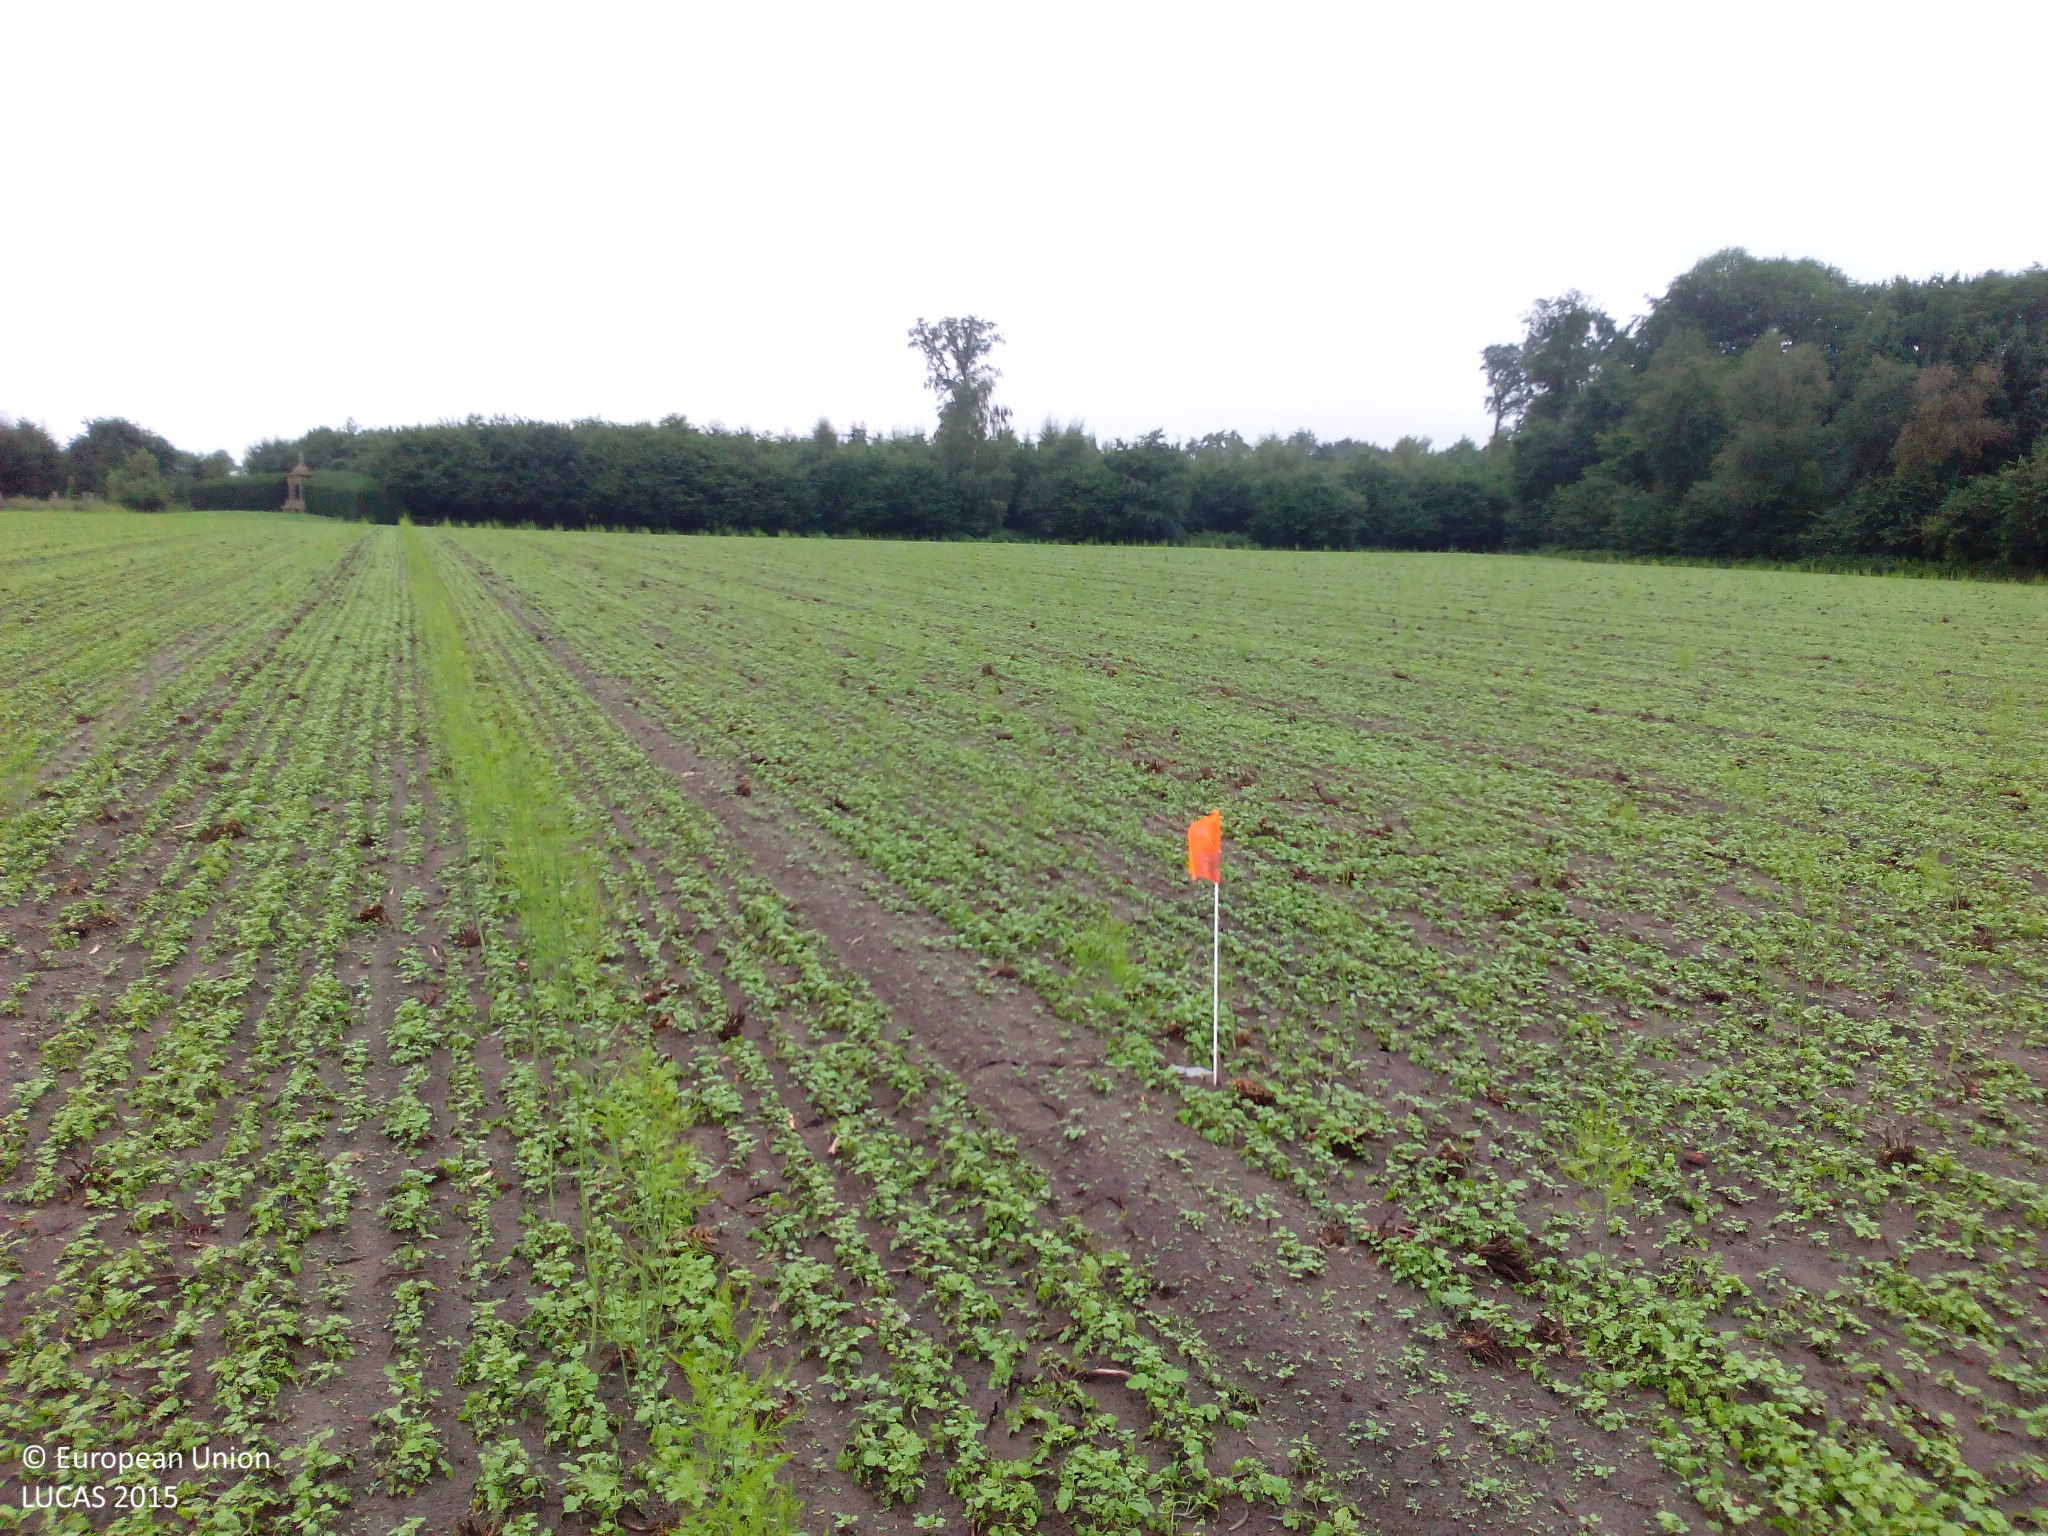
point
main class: Cropland
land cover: Other fresh vegetables
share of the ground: 10 - 25 %
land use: Agriculture (excluding fallow land and kitchen gardens)
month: August
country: DE
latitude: 52.0555
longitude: 8.0316
